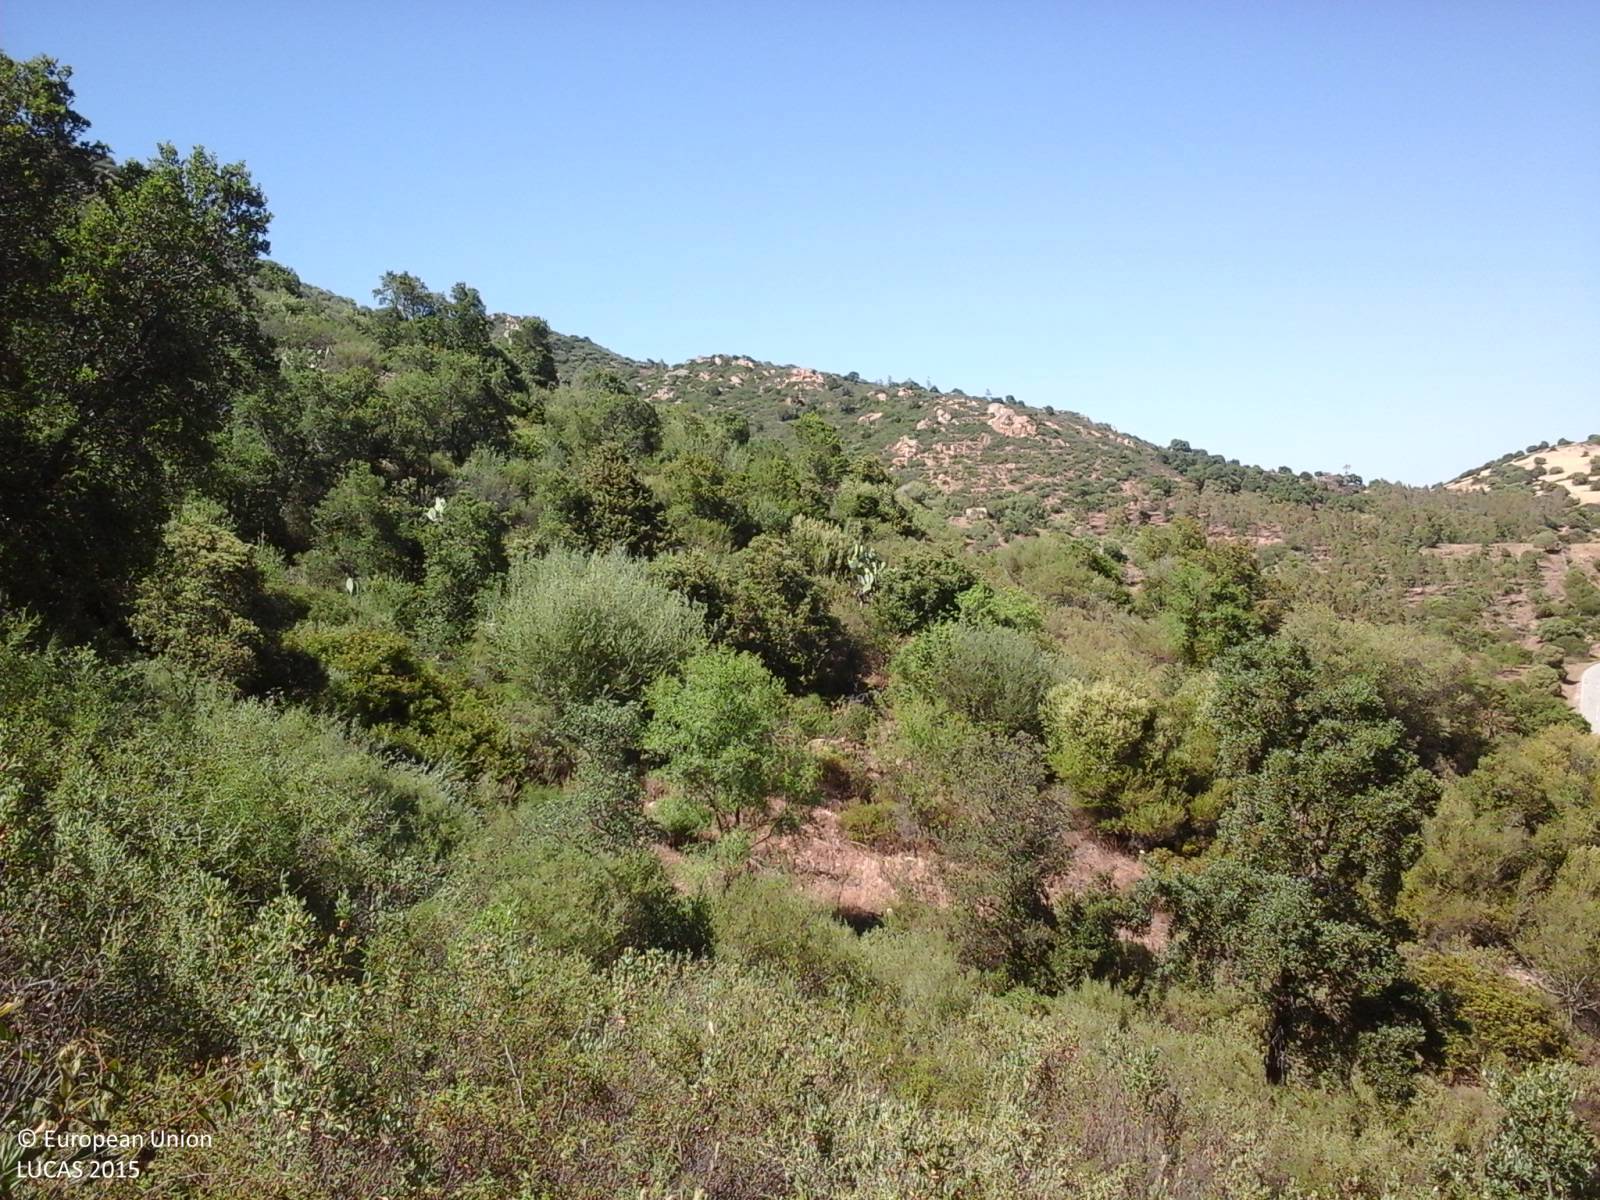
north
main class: Shrubland
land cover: Shrubland without tree cover
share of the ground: > 75 %
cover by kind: shrubs 95 %, herbaceous plants 5 %
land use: Semi-natural and natural areas not in use
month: May
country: IT
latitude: 40.3381
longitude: 9.4262
